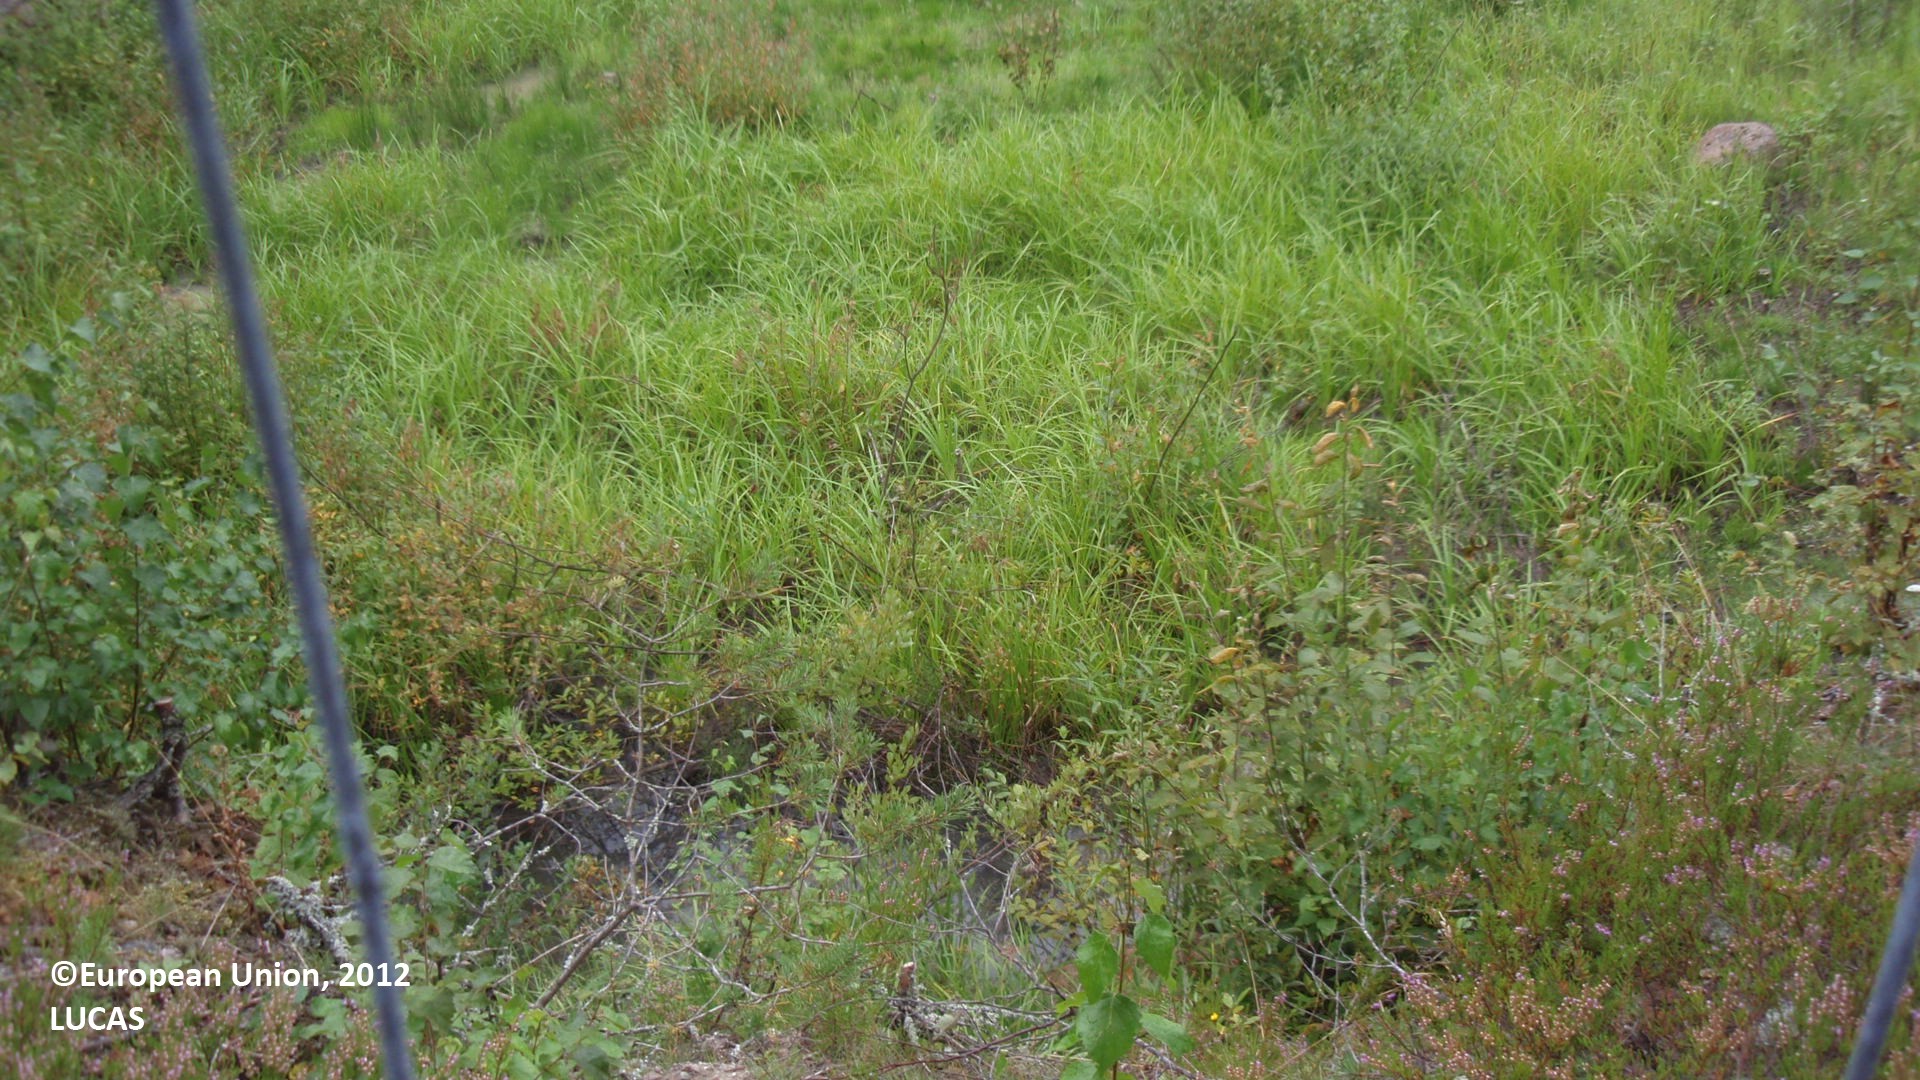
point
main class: Grassland
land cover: Grassland with sparse tree/shrub cover
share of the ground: > 75 %
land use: Abandoned areas
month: August
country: FI
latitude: 60.5683
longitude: 27.0850
